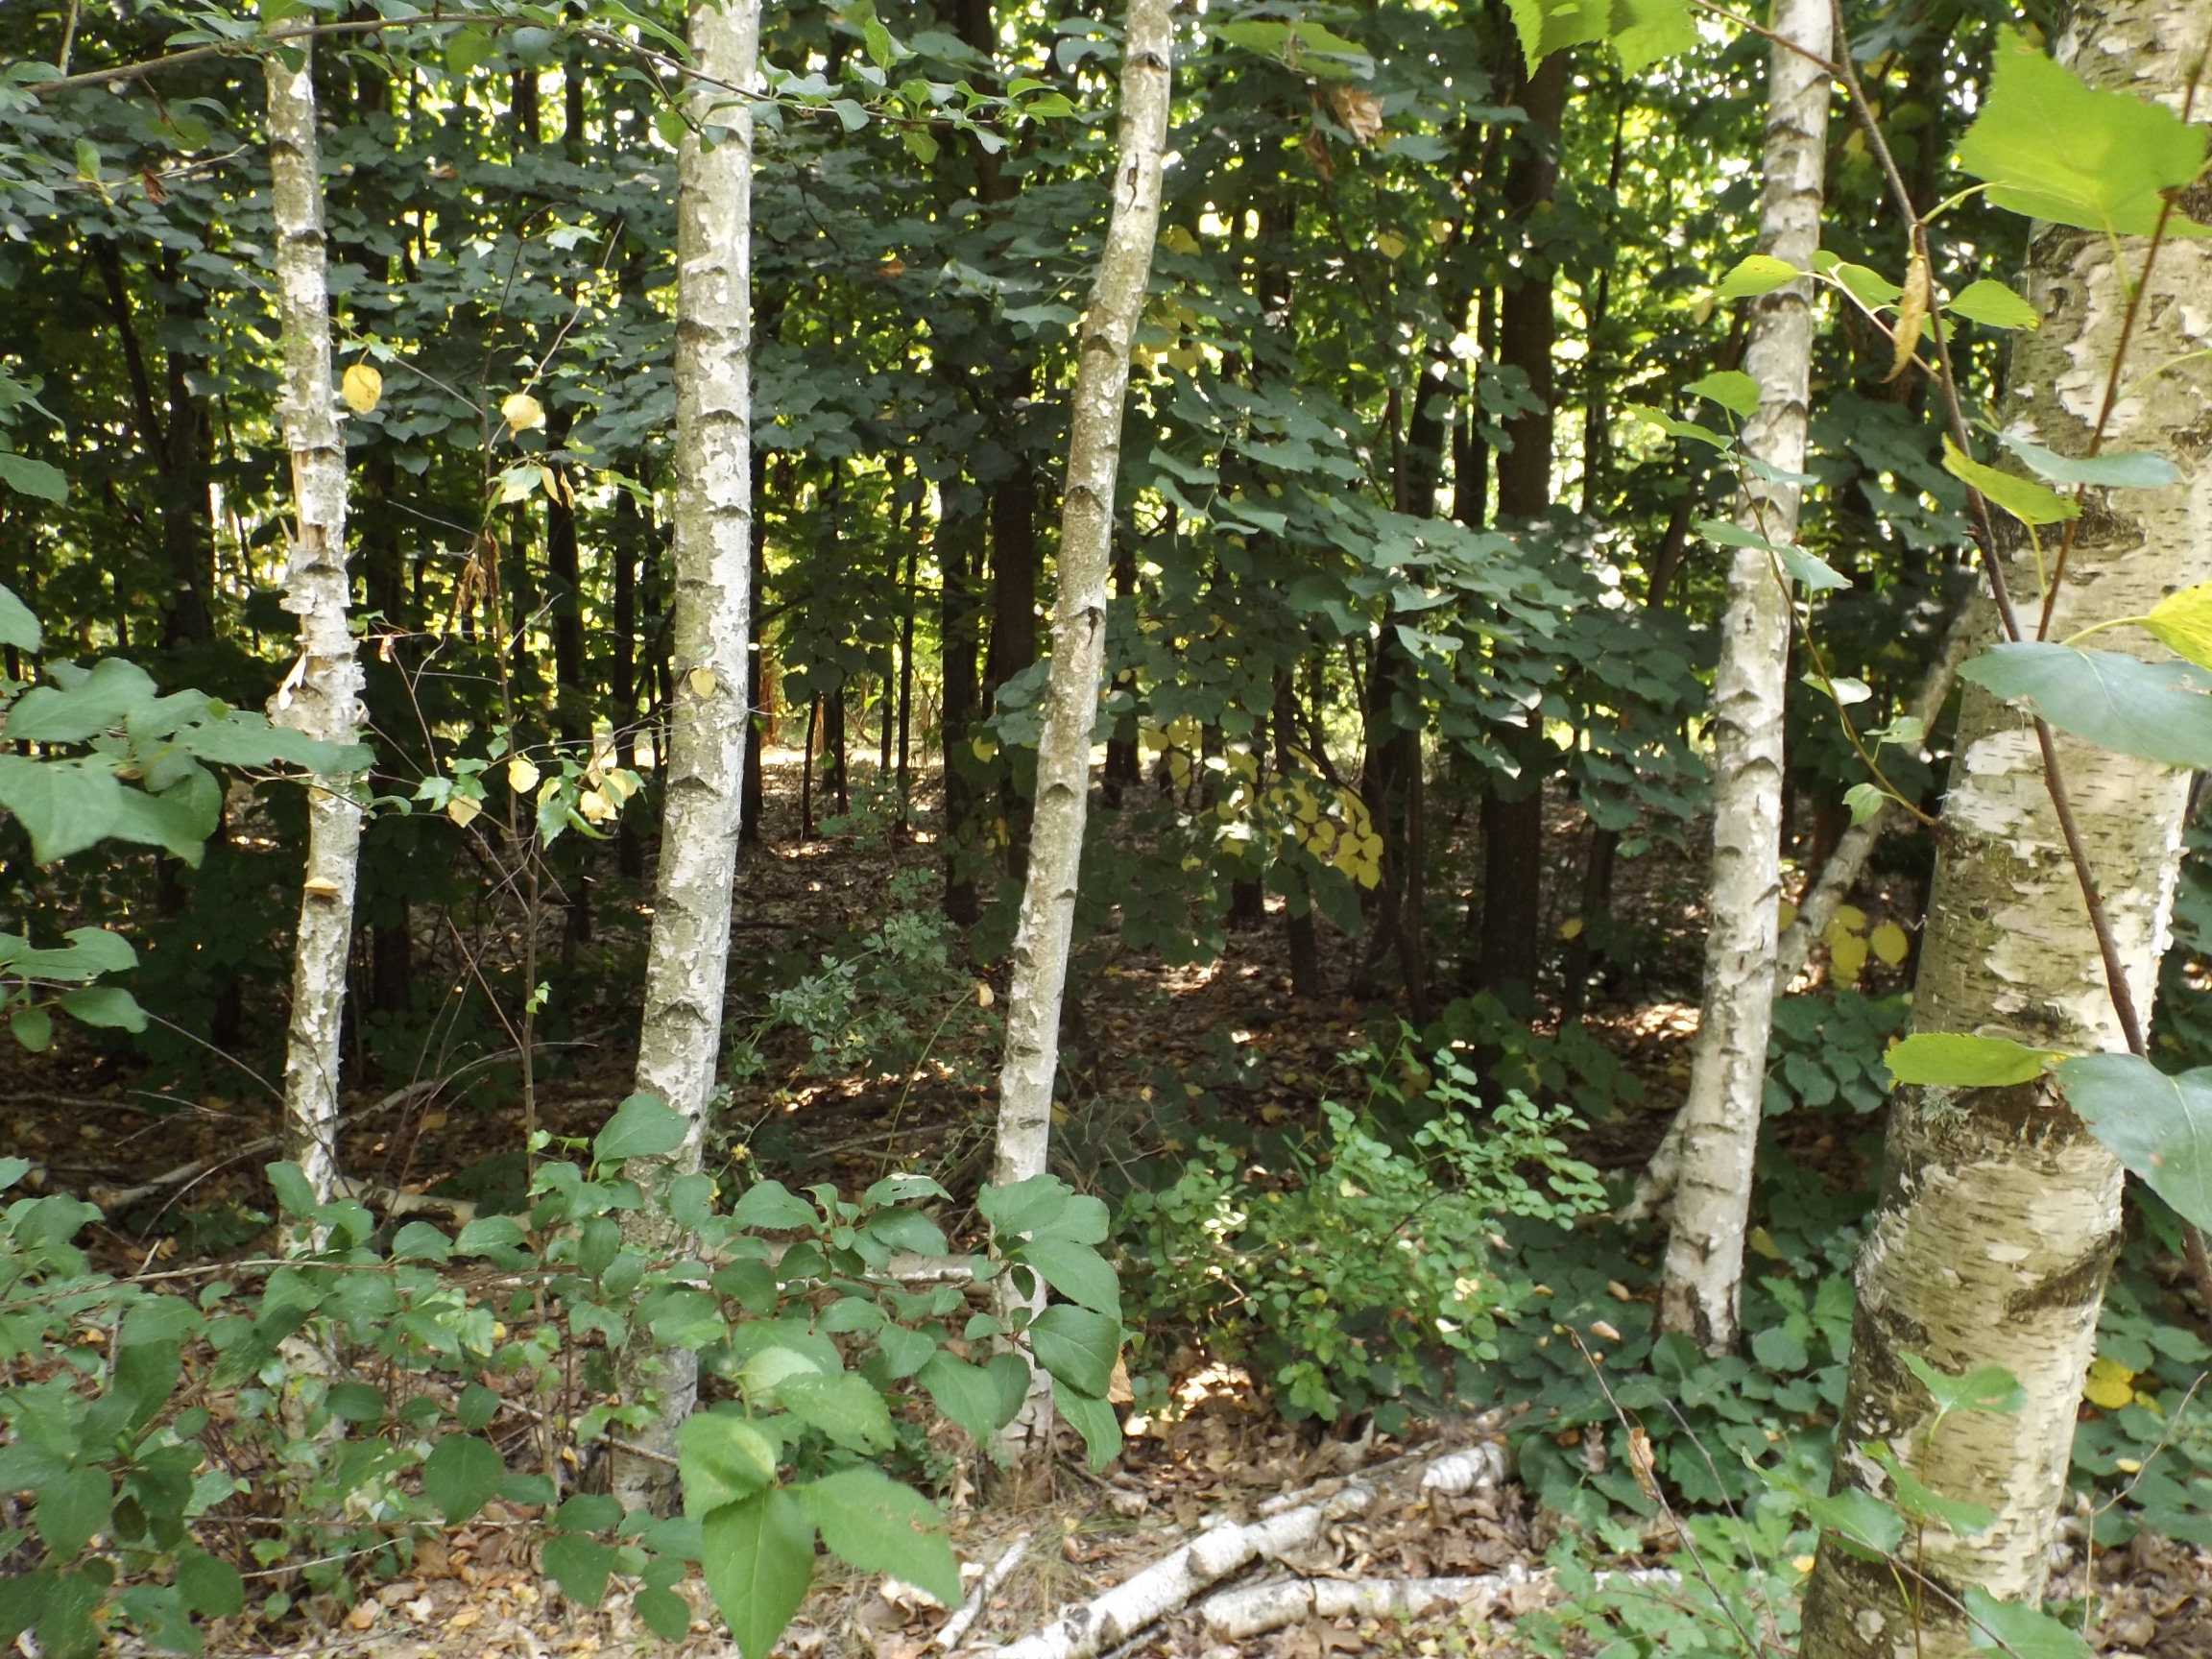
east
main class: Woodland
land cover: Broadleaved woodland
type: non-riverine alder, birch or aspen forest
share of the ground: > 75 %
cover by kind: broadleaved forest trees 95 %, herbaceous plants 5 %
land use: Forestry
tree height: > 5 m
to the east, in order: Broadleaved woodland; Grass margins; Sunflower; Grass margins; Fences; Grassland without tree/shrub cover
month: July
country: BG
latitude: 43.4413
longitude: 27.5912
